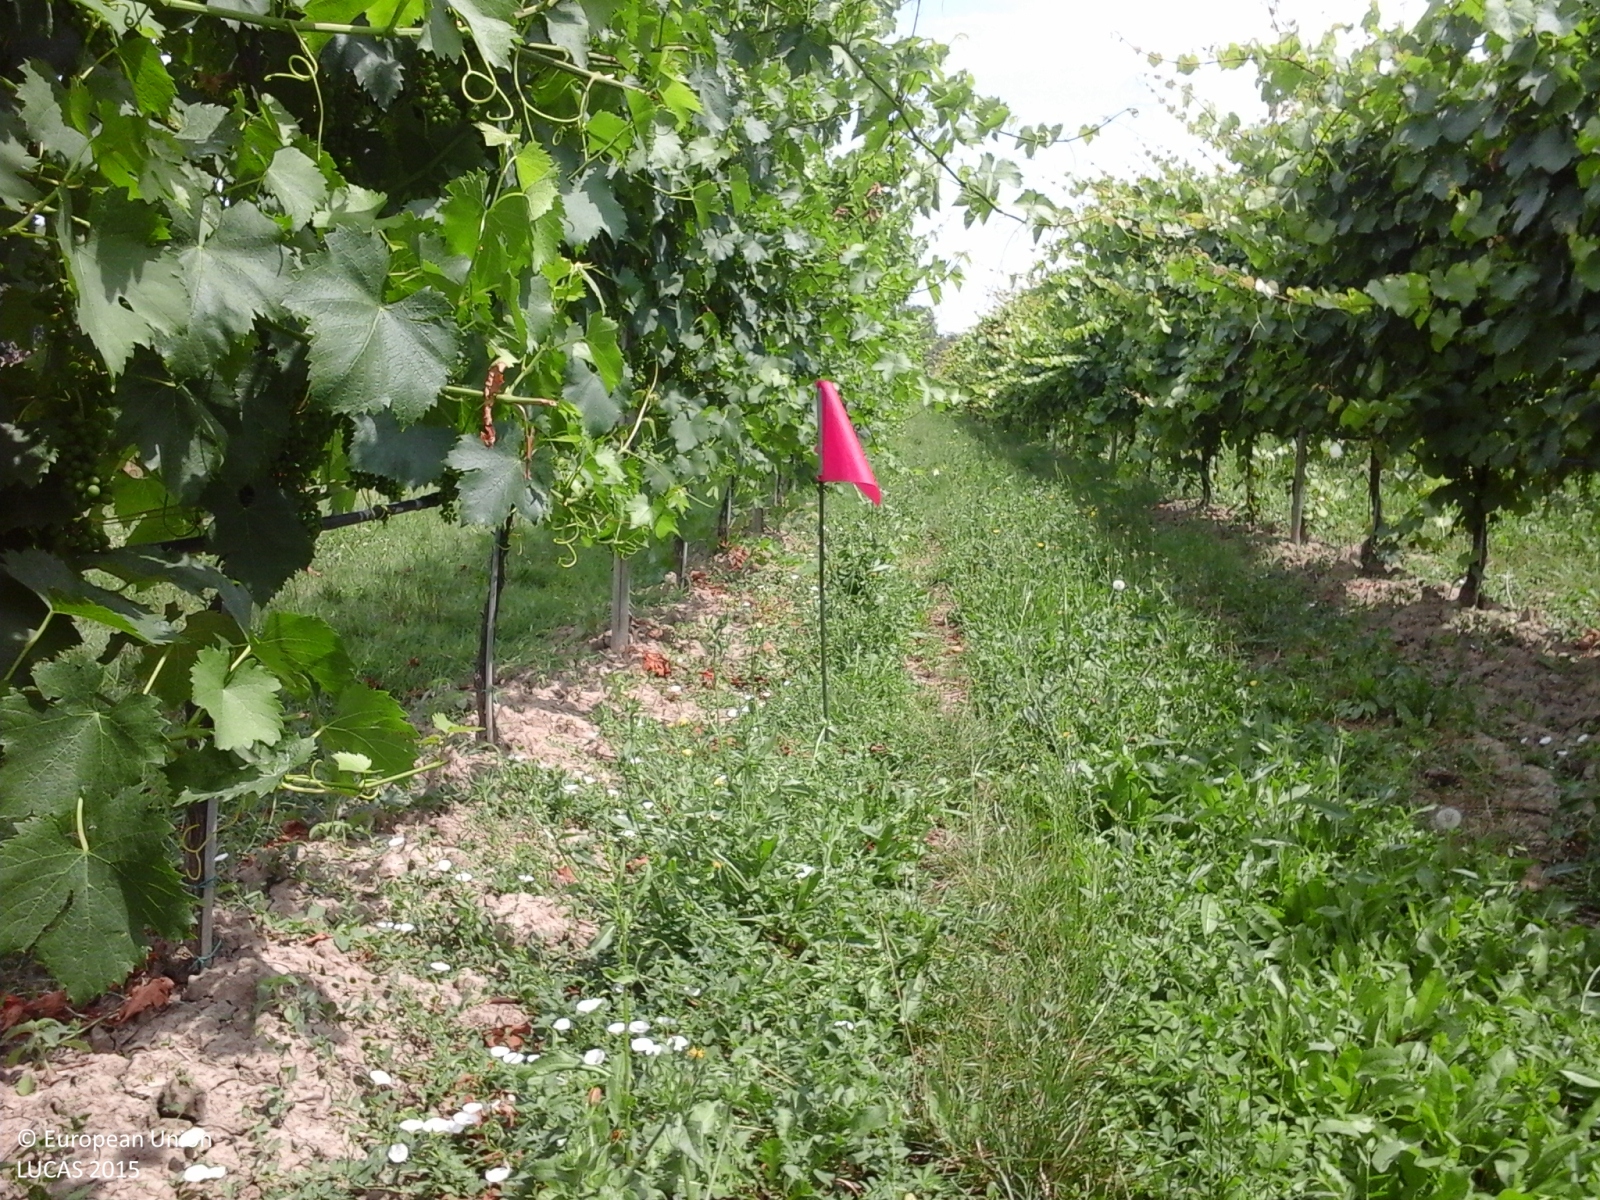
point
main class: Cropland
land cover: Vineyards
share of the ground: 50 - 75 %
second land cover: Grassland without tree/shrub cover
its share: > 75 %
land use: Agriculture (excluding fallow land and kitchen gardens)
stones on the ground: < 10 %
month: June
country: IT
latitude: 44.6519
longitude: 11.0444
